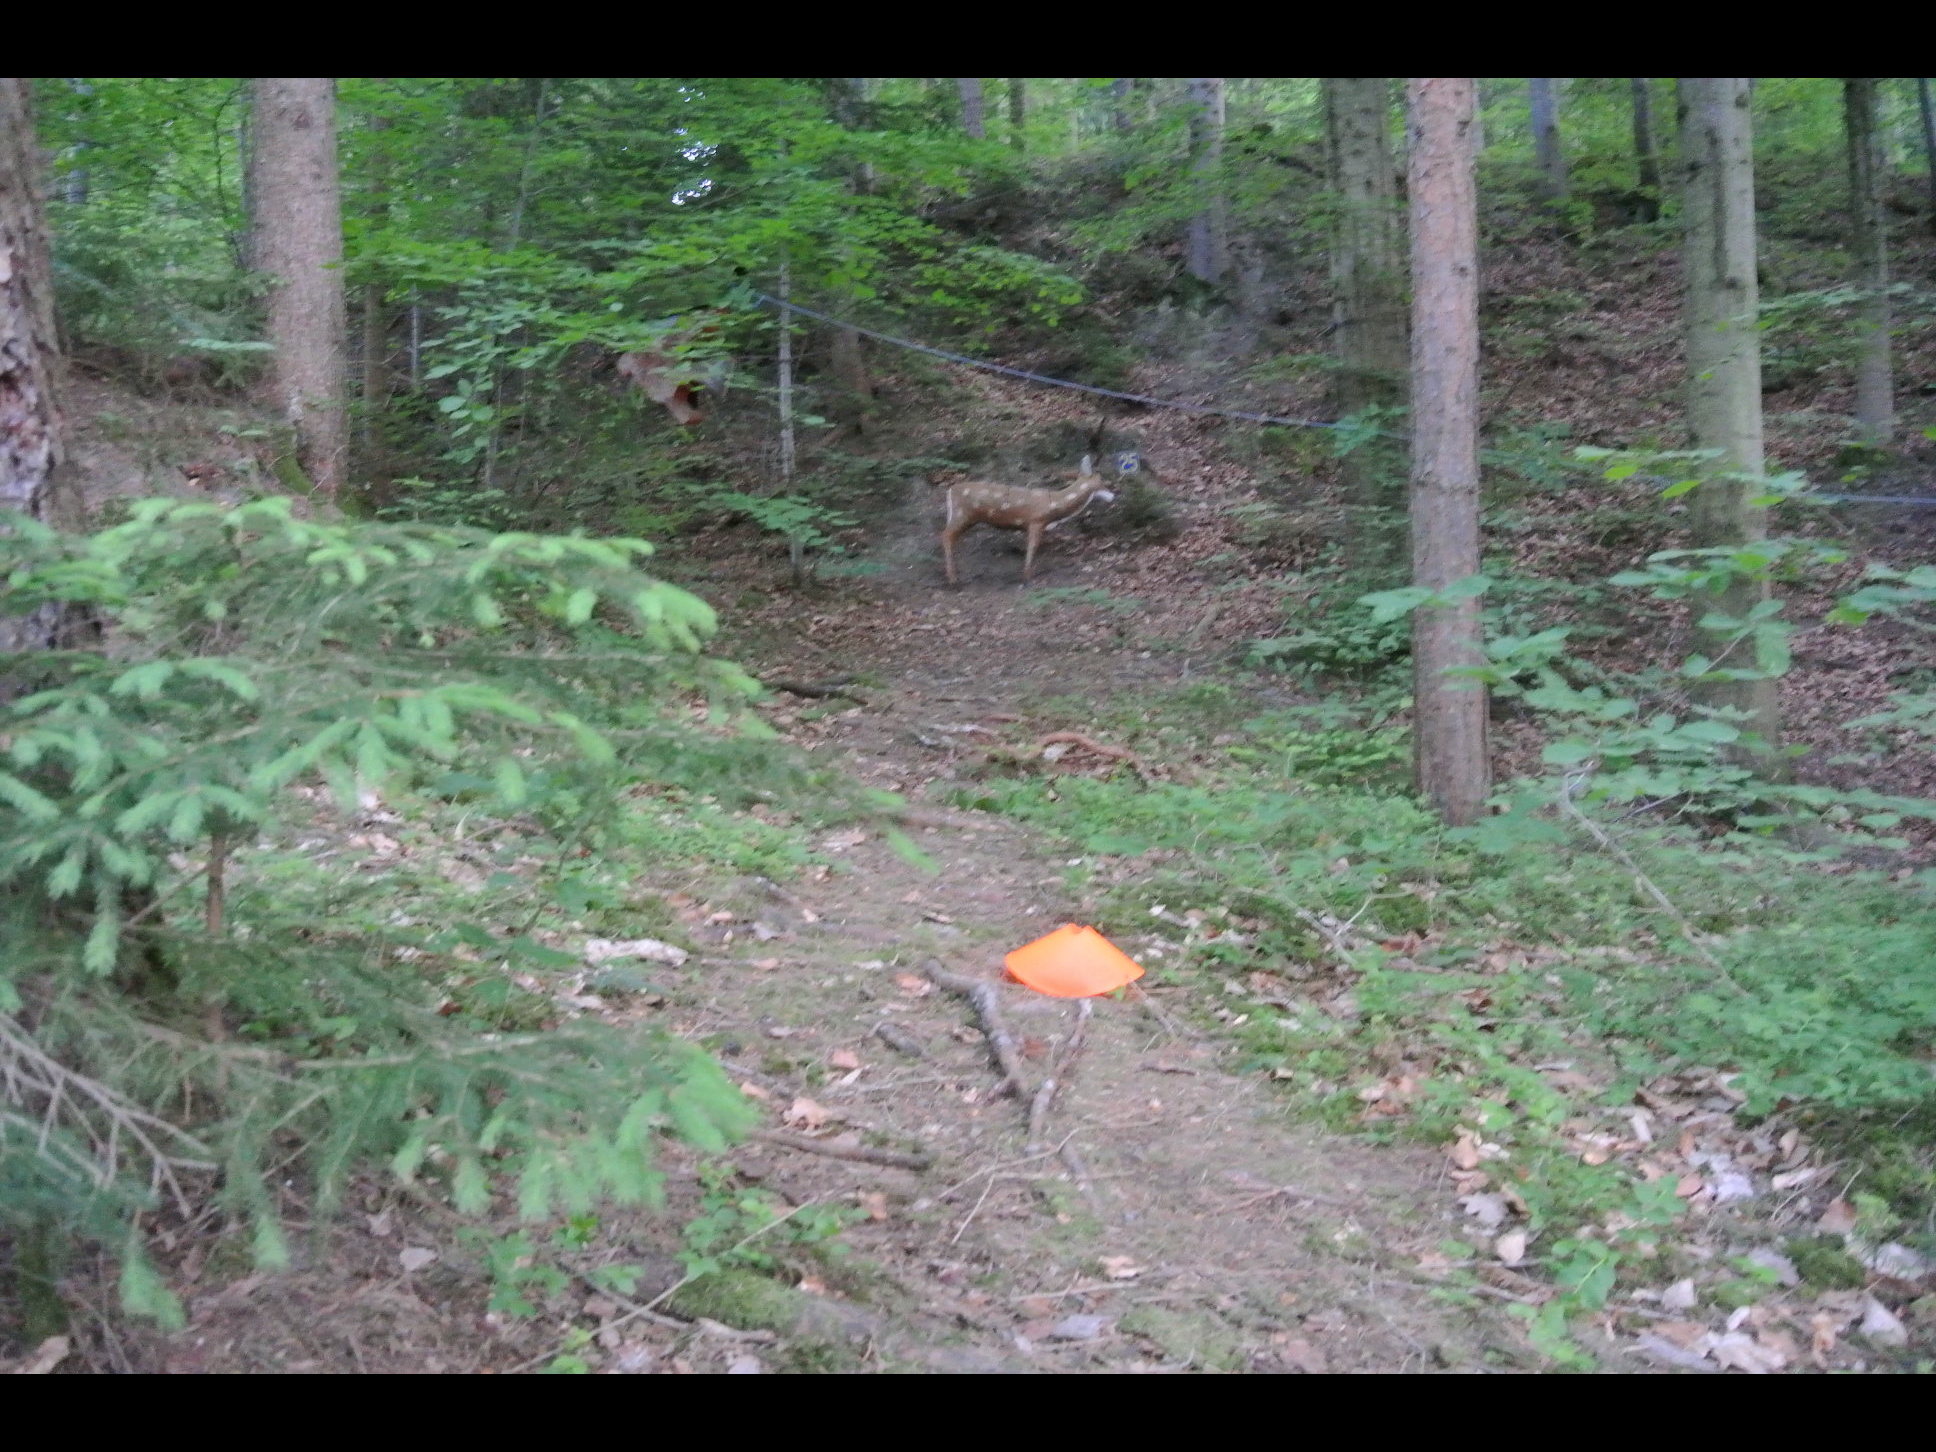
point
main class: Woodland
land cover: Other mixed woodland
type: mesophytic deciduous forest
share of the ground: > 75 %
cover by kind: coniferous forest trees 70 %, broadleaved forest trees 30 %
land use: Forestry
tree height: > 5 m
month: May
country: AT
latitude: 47.6907
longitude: 15.8245
